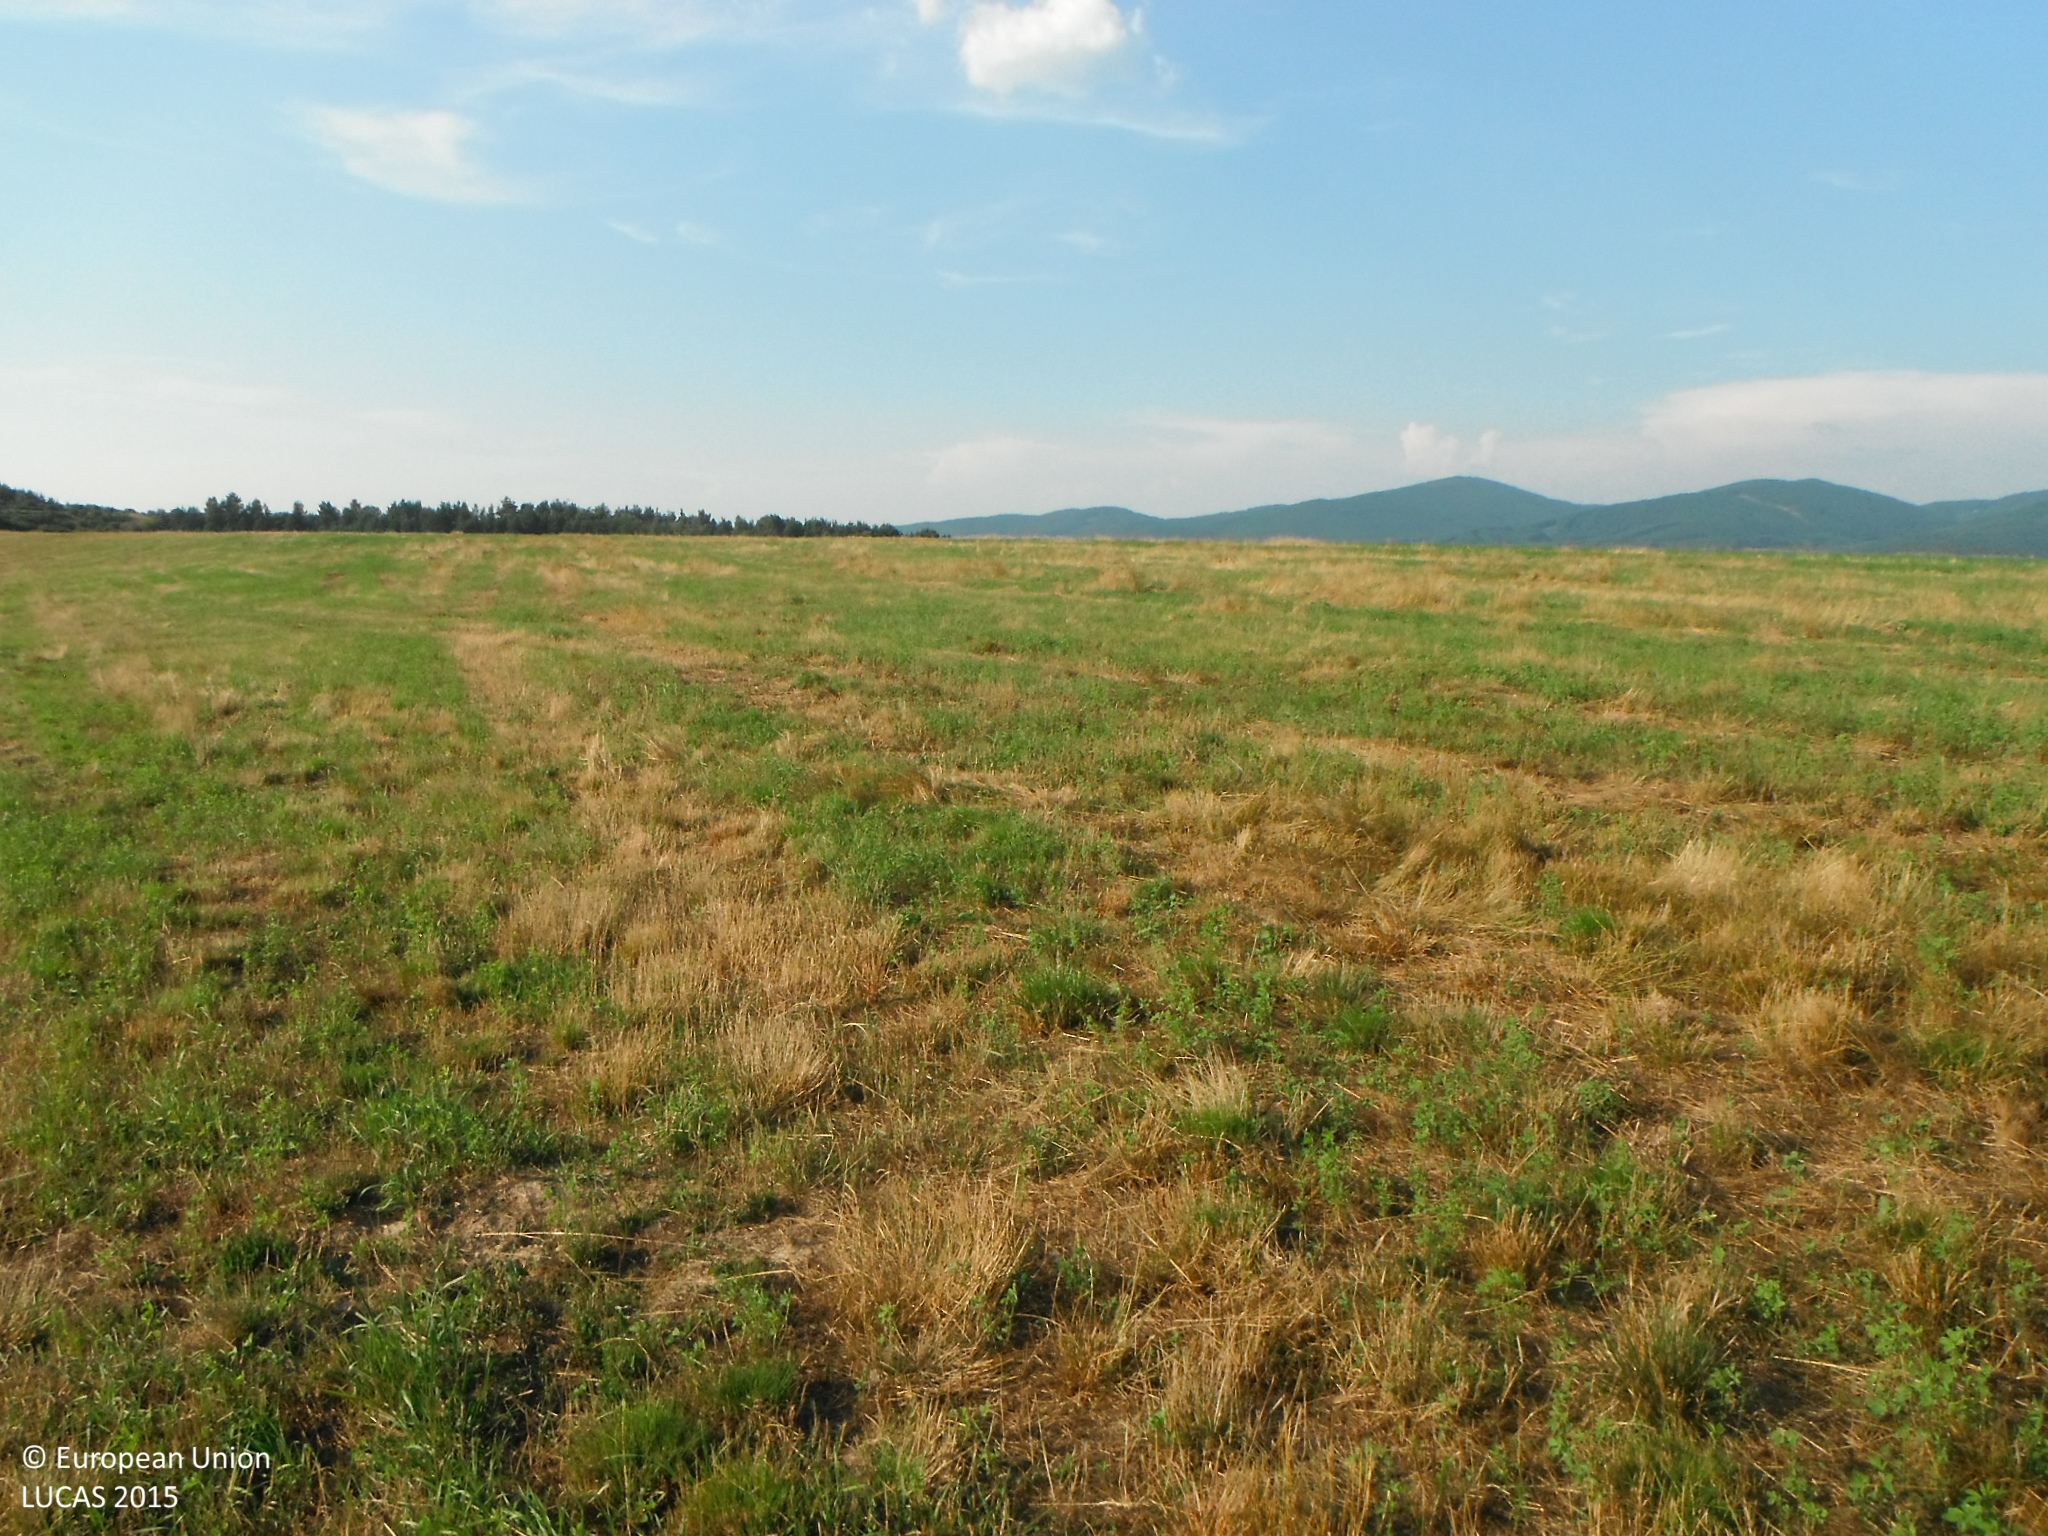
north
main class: Cropland
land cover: Other leguminous and mixtures for fodder
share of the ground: > 75 %
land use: Agriculture (excluding fallow land and kitchen gardens)
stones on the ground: < 10 %
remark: Harvested field
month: August
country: SK
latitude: 48.4246
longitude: 19.1160
